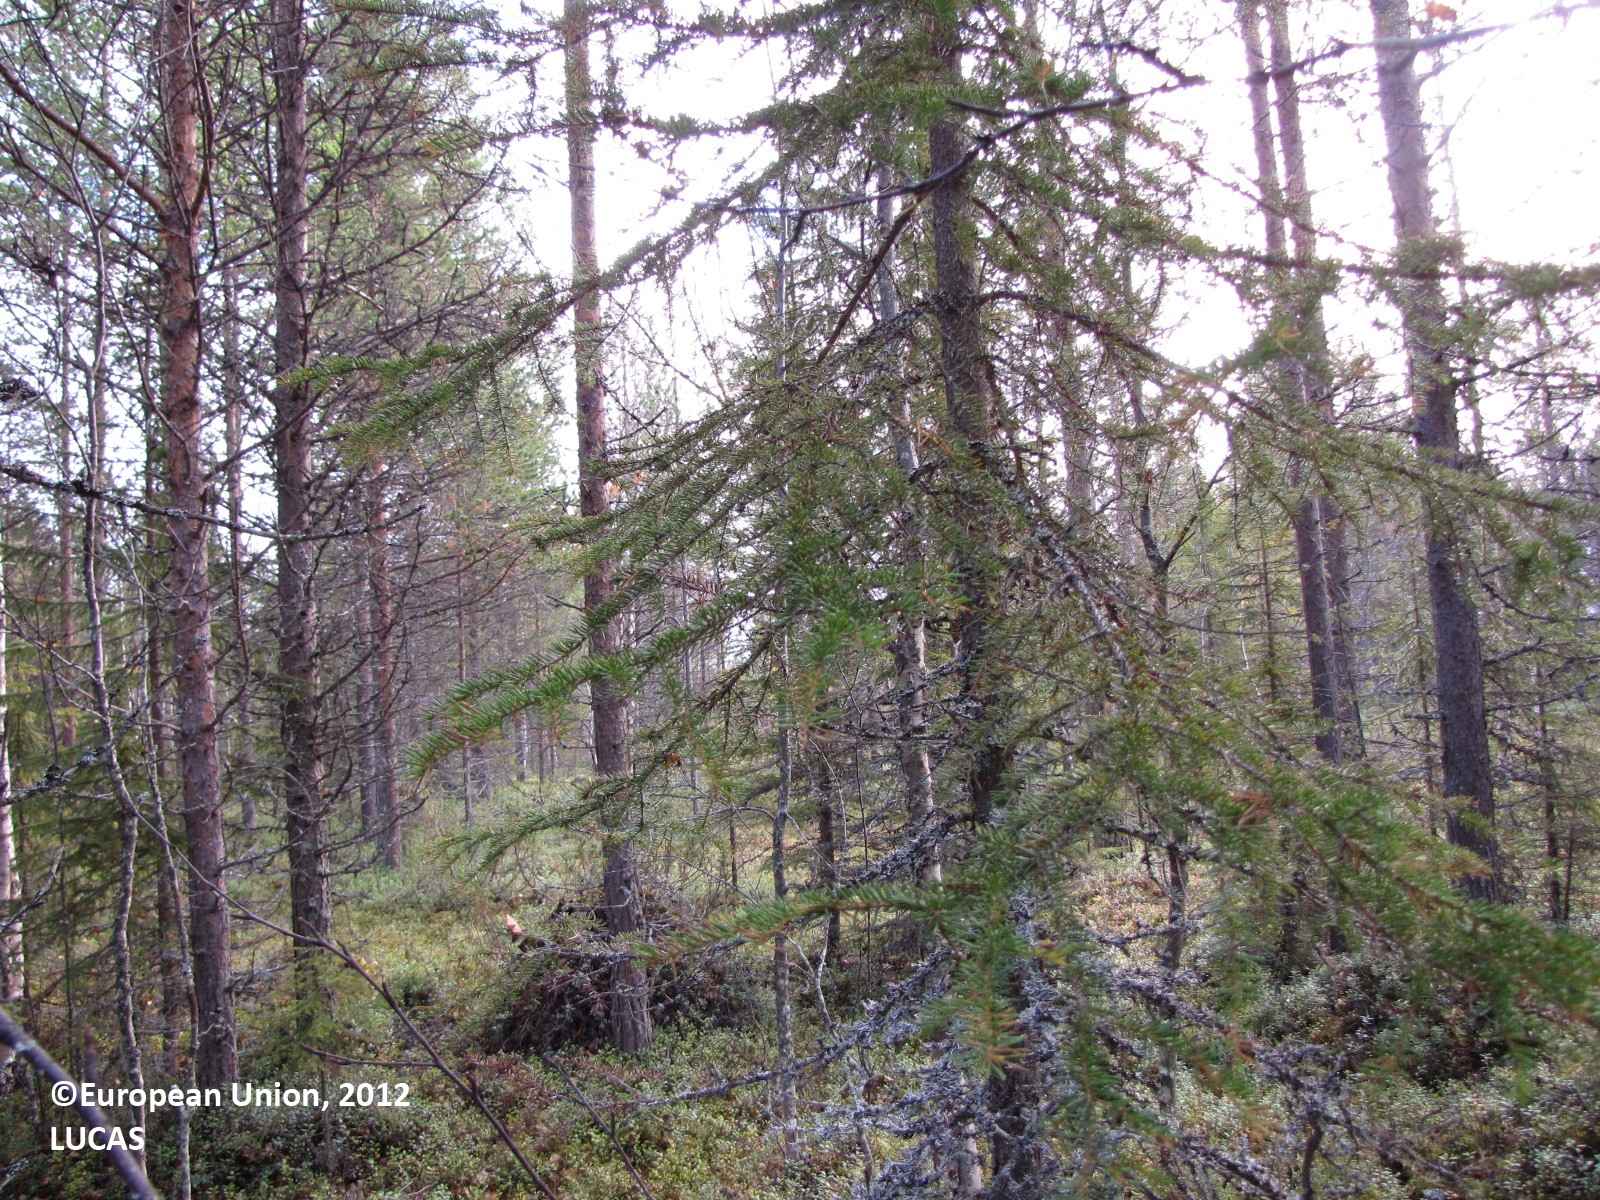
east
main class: Woodland
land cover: Pine dominated coniferous woodland
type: boreal forest
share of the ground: 25 - 50 %
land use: Forestry
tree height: > 5 m
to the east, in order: Pine dominated coniferous woodland; Pine dominated mixed woodland; Tracks; Pine dominated mixed woodland; Ditches and canals; Spruce dominated mixed woodland; Pine dominated coniferous woodland
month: September
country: FI
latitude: 67.7322
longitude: 25.1978
